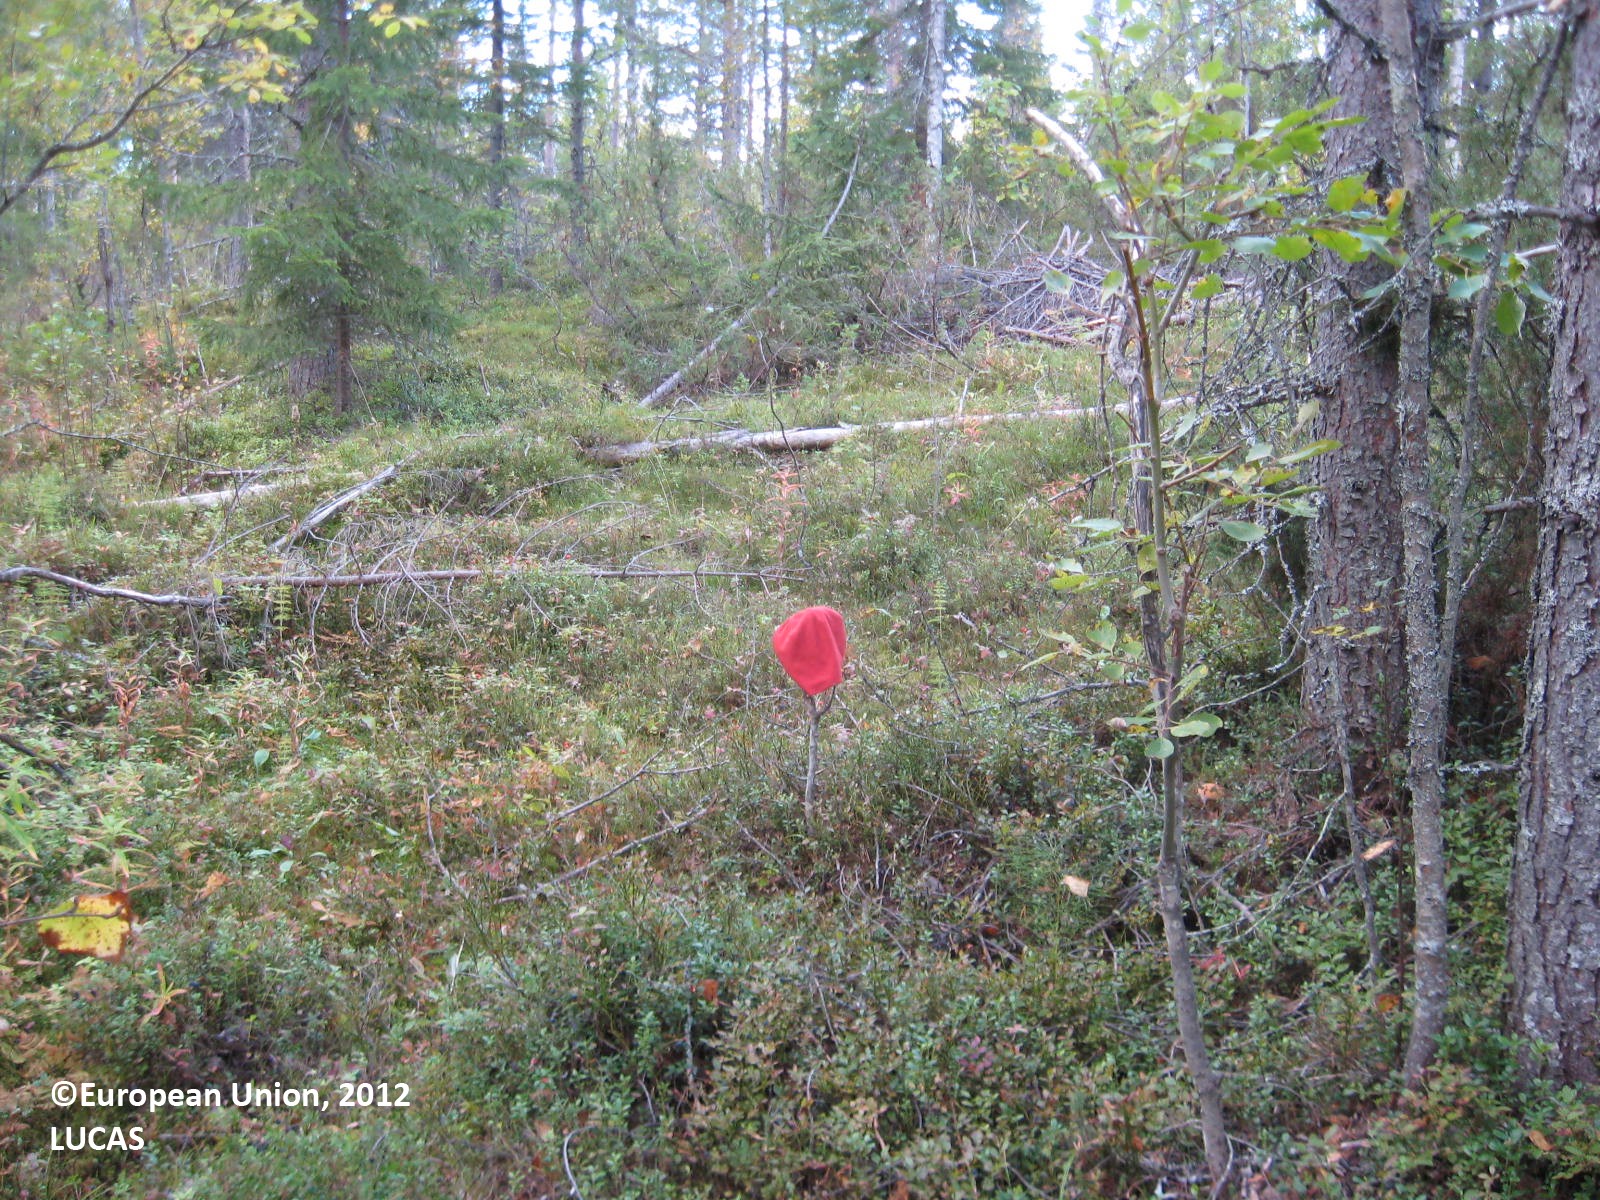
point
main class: Woodland
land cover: Other coniferous woodland
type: boreal forest
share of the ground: > 75 %
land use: Forestry
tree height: > 5 m
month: August
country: FI
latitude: 63.9477
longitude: 29.8472
